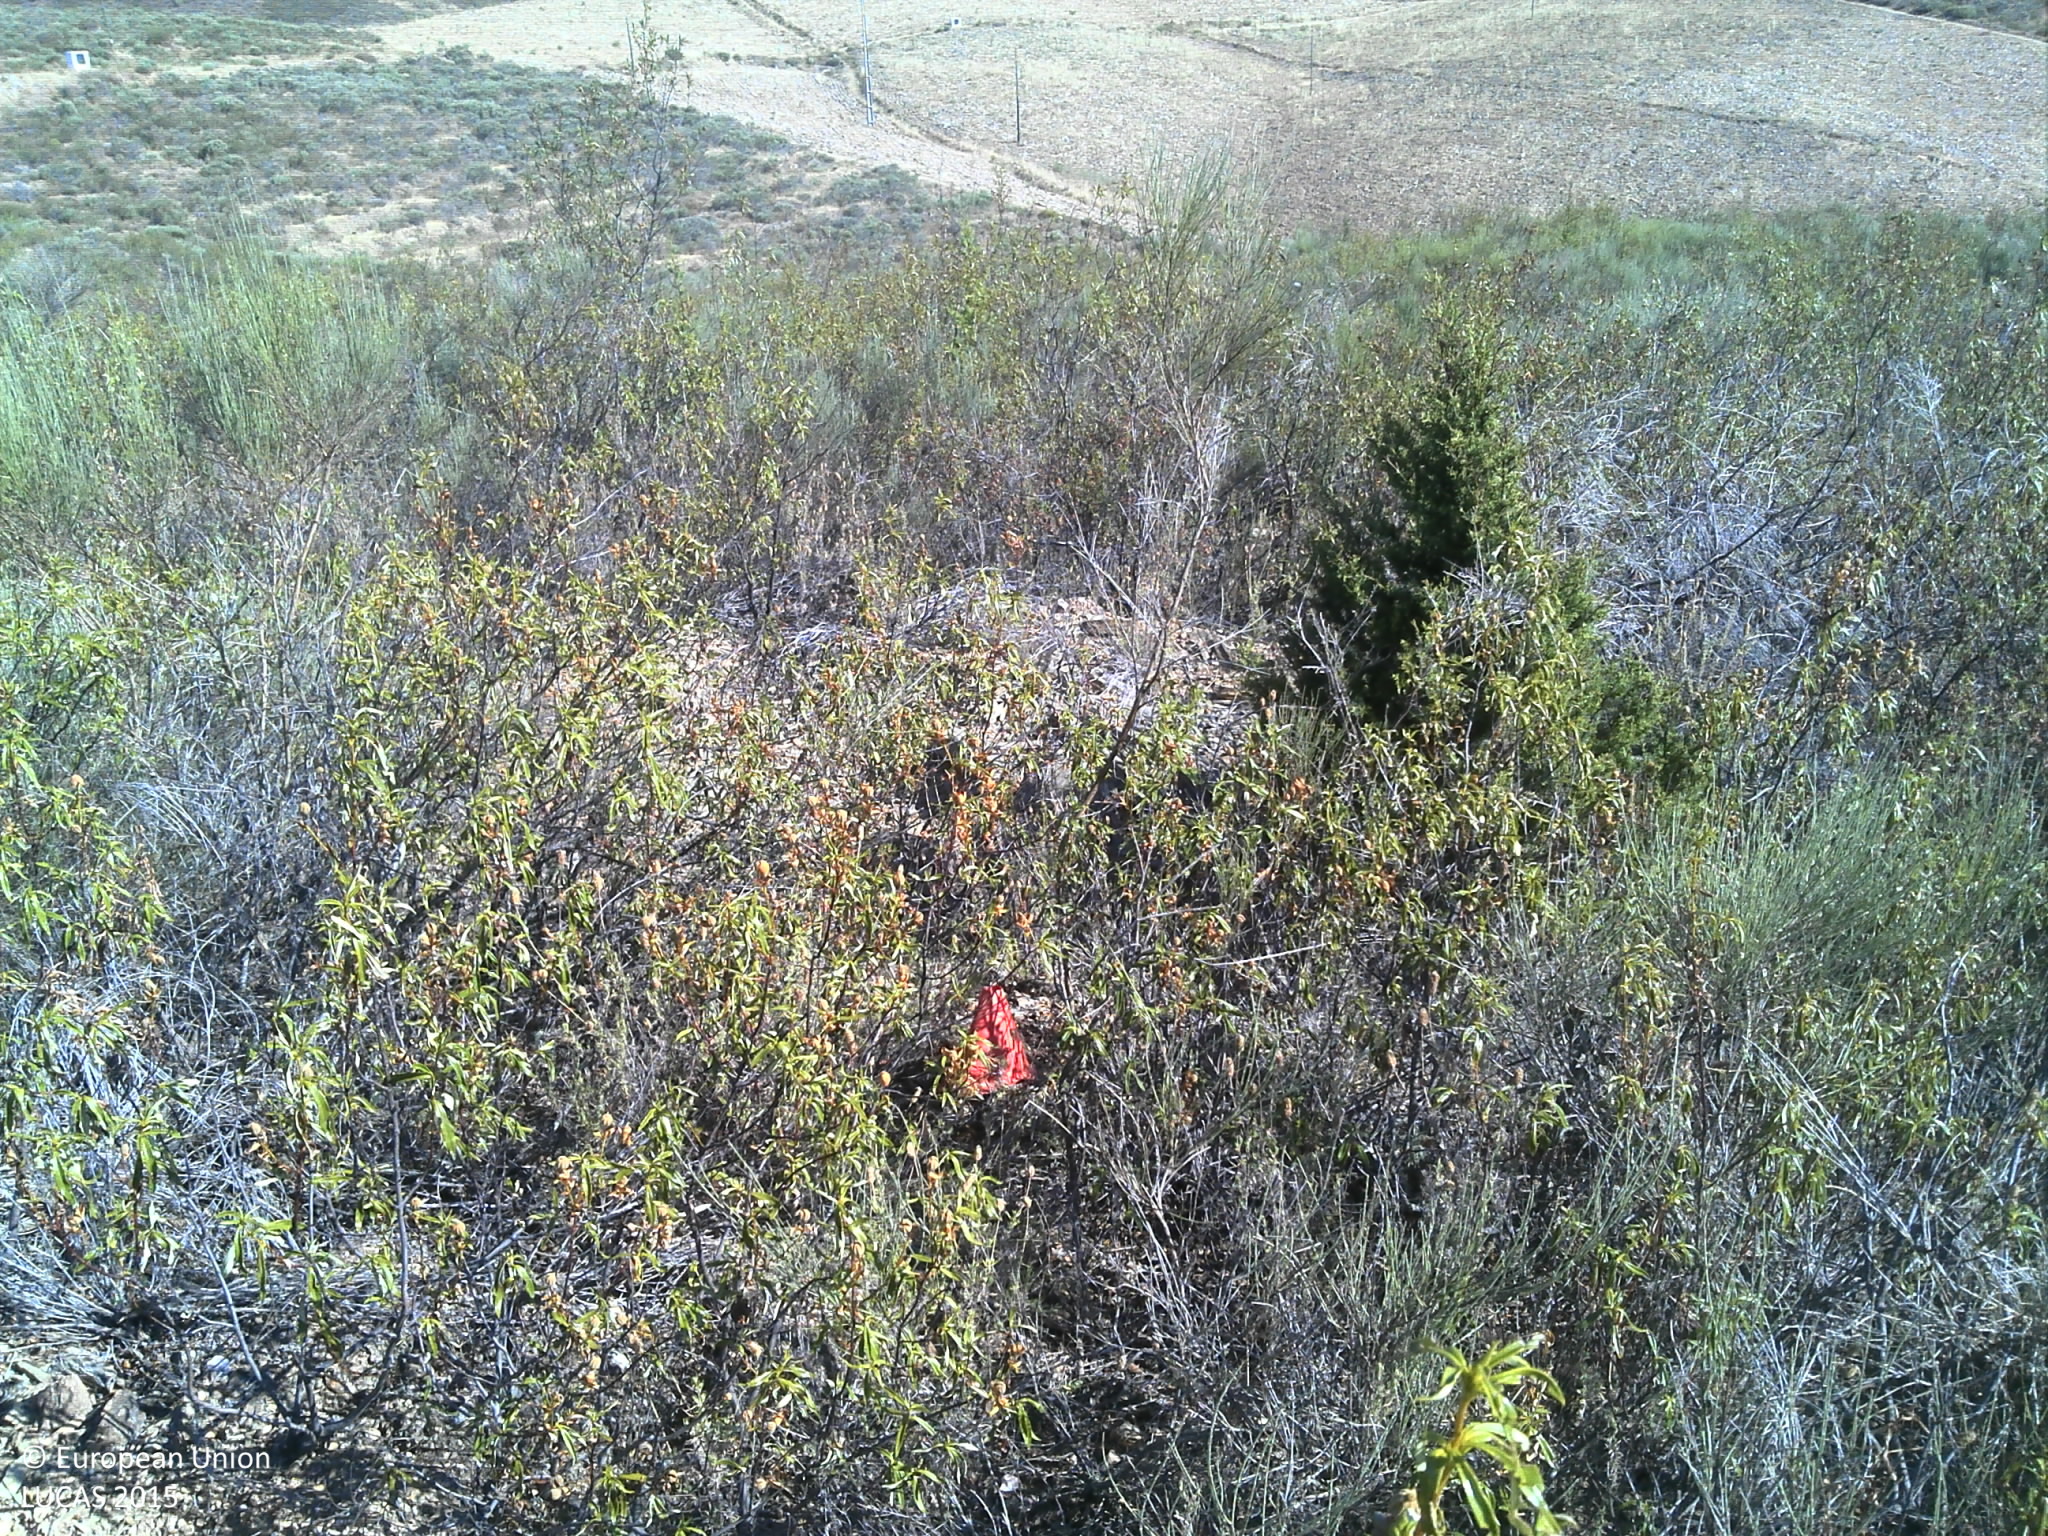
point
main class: Shrubland
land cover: Shrubland with sparse tree cover
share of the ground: > 75 %
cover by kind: shrubs 95 %, coniferous forest trees 5 %
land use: Abandoned areas
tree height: < 5 m
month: July
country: PT
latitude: 41.0936
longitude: -7.0021
